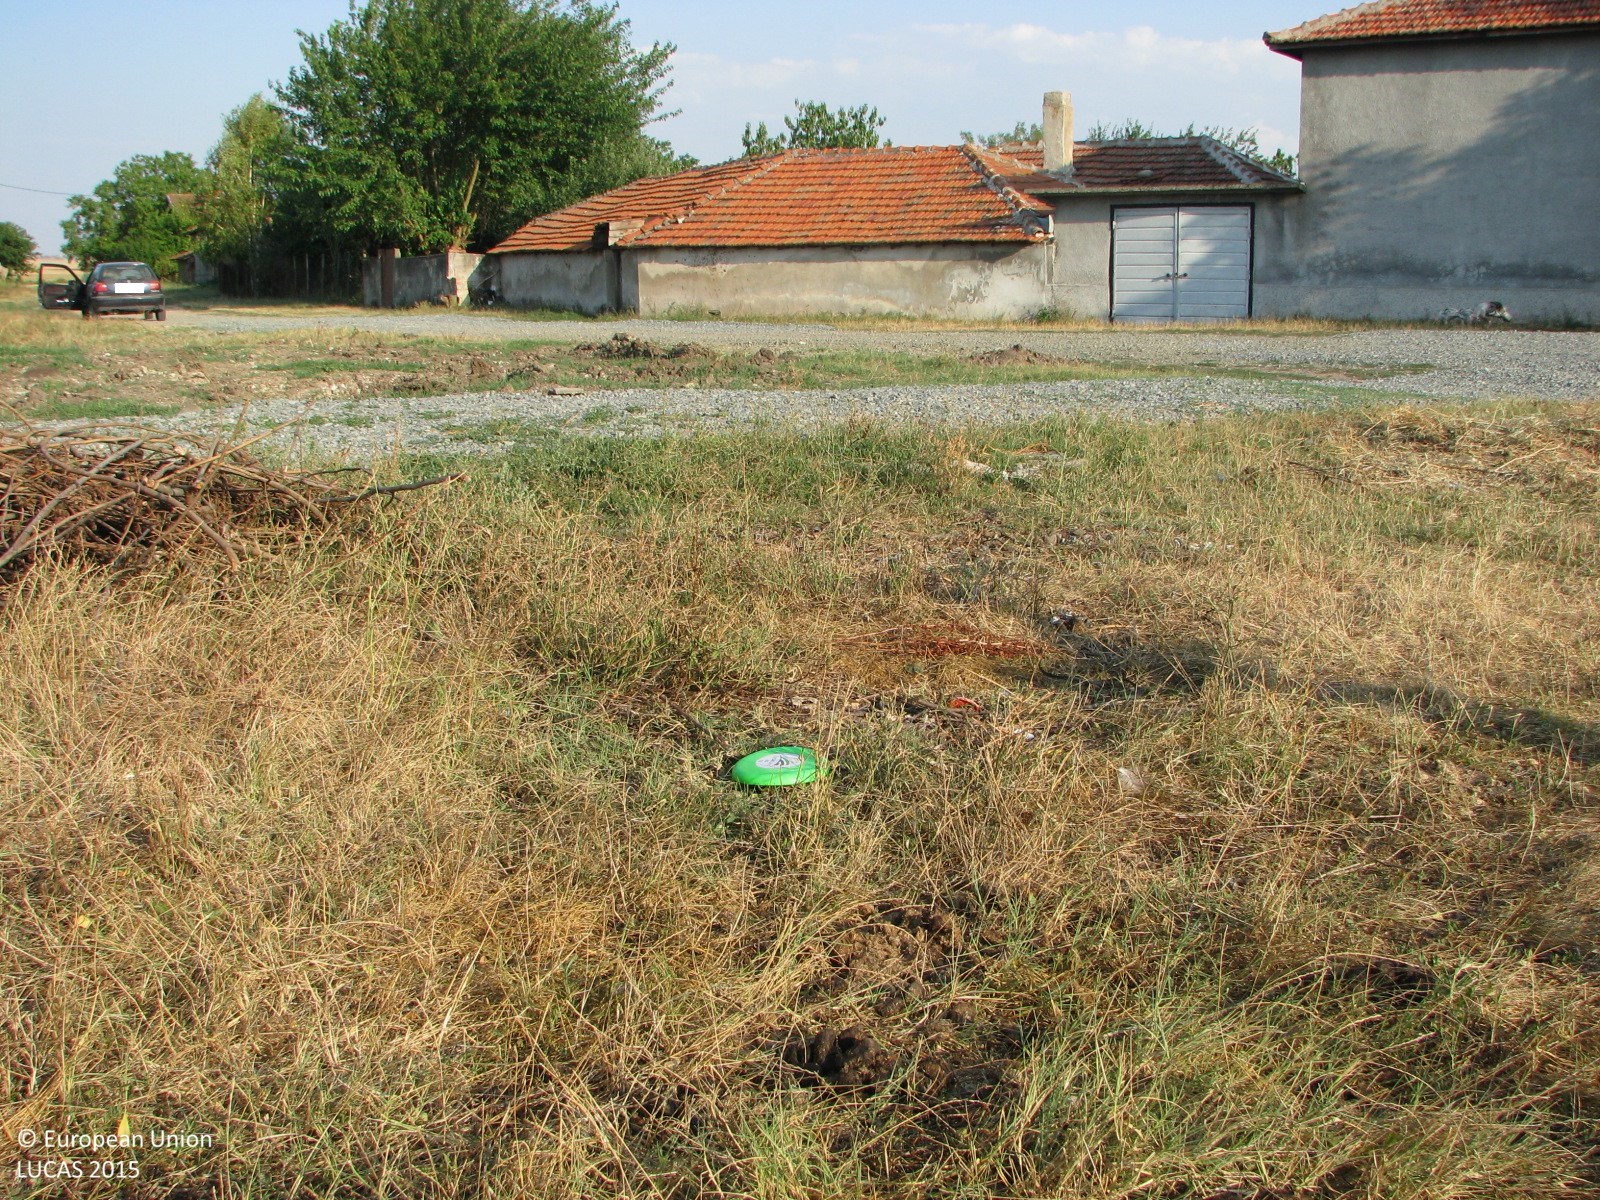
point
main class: Grassland
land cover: Grassland without tree/shrub cover
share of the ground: > 75 %
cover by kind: herbaceous plants 100 %
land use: Residential
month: August
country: BG
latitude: 42.5138
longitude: 26.6614
